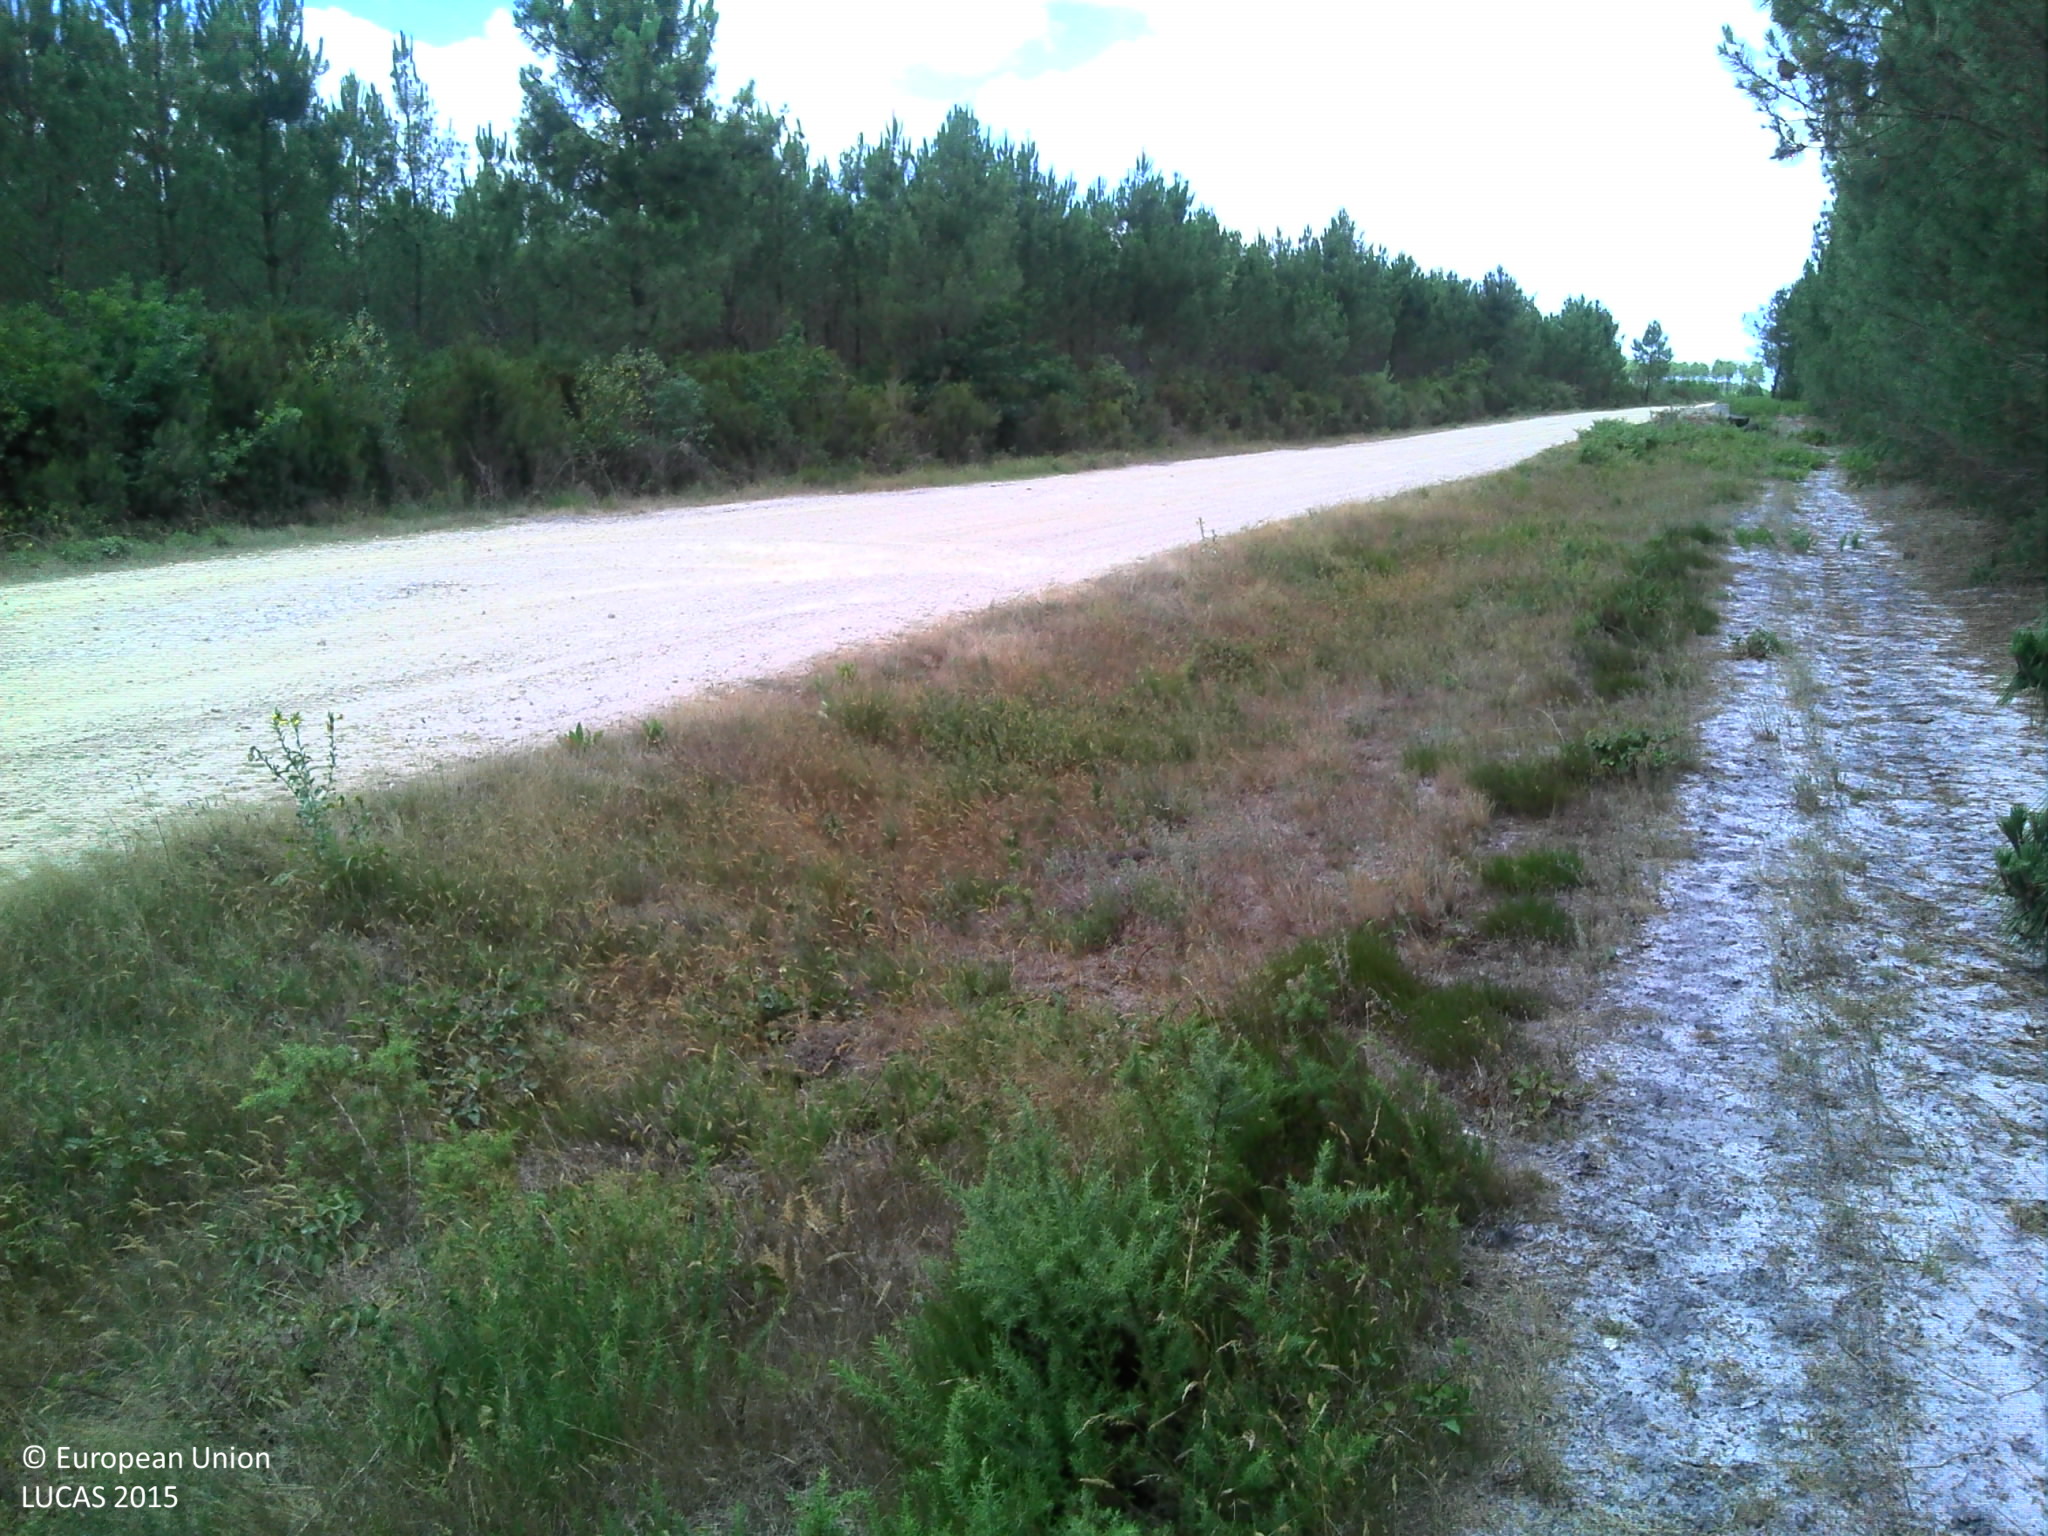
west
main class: Woodland
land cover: Pine dominated coniferous woodland
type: coniferous forest of the mediterranean region
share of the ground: > 75 %
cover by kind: coniferous forest trees 90 %, shrubs 5 %, herbaceous plants 5 %
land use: Forestry
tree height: > 5 m
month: July
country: FR
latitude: 44.2653
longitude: -0.9039
